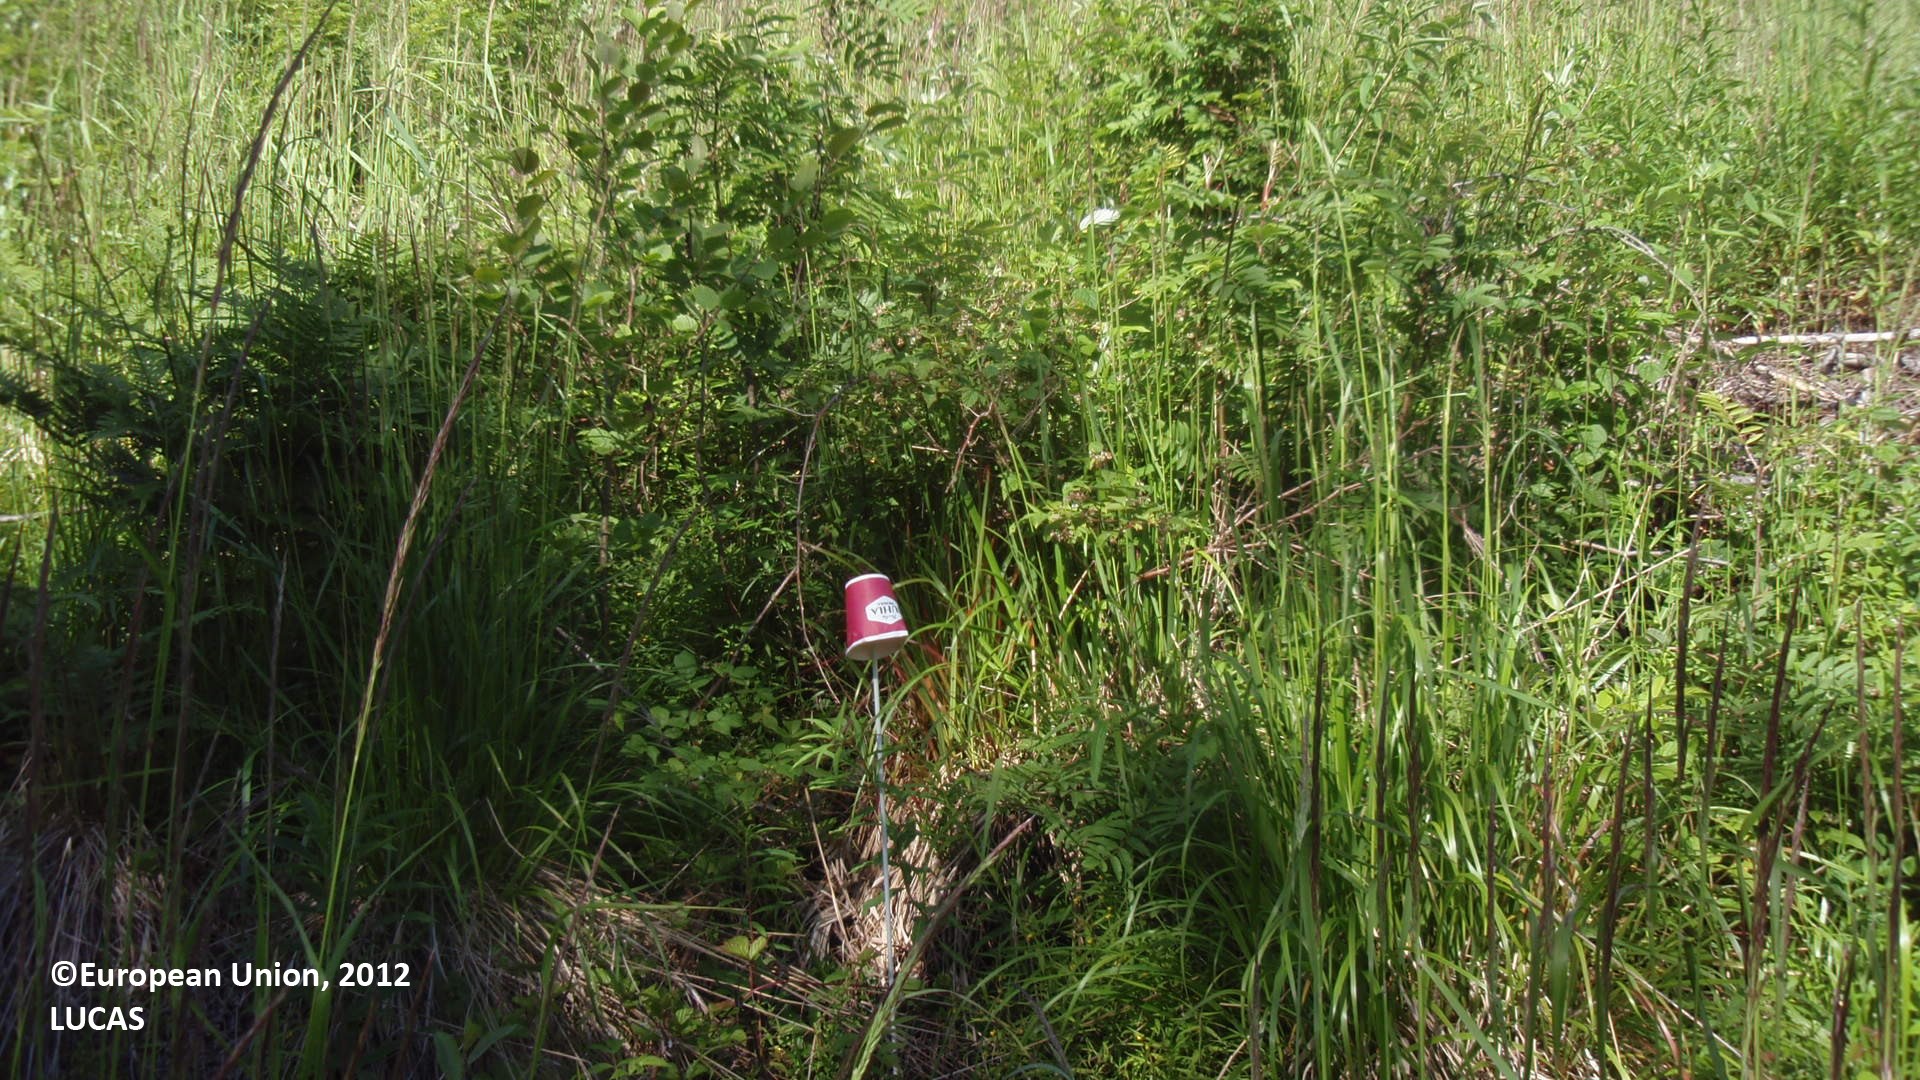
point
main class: Grassland
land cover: Grassland with sparse tree/shrub cover
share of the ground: > 75 %
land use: Forestry
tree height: < 5 m
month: July
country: FI
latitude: 61.5884
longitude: 28.8573
